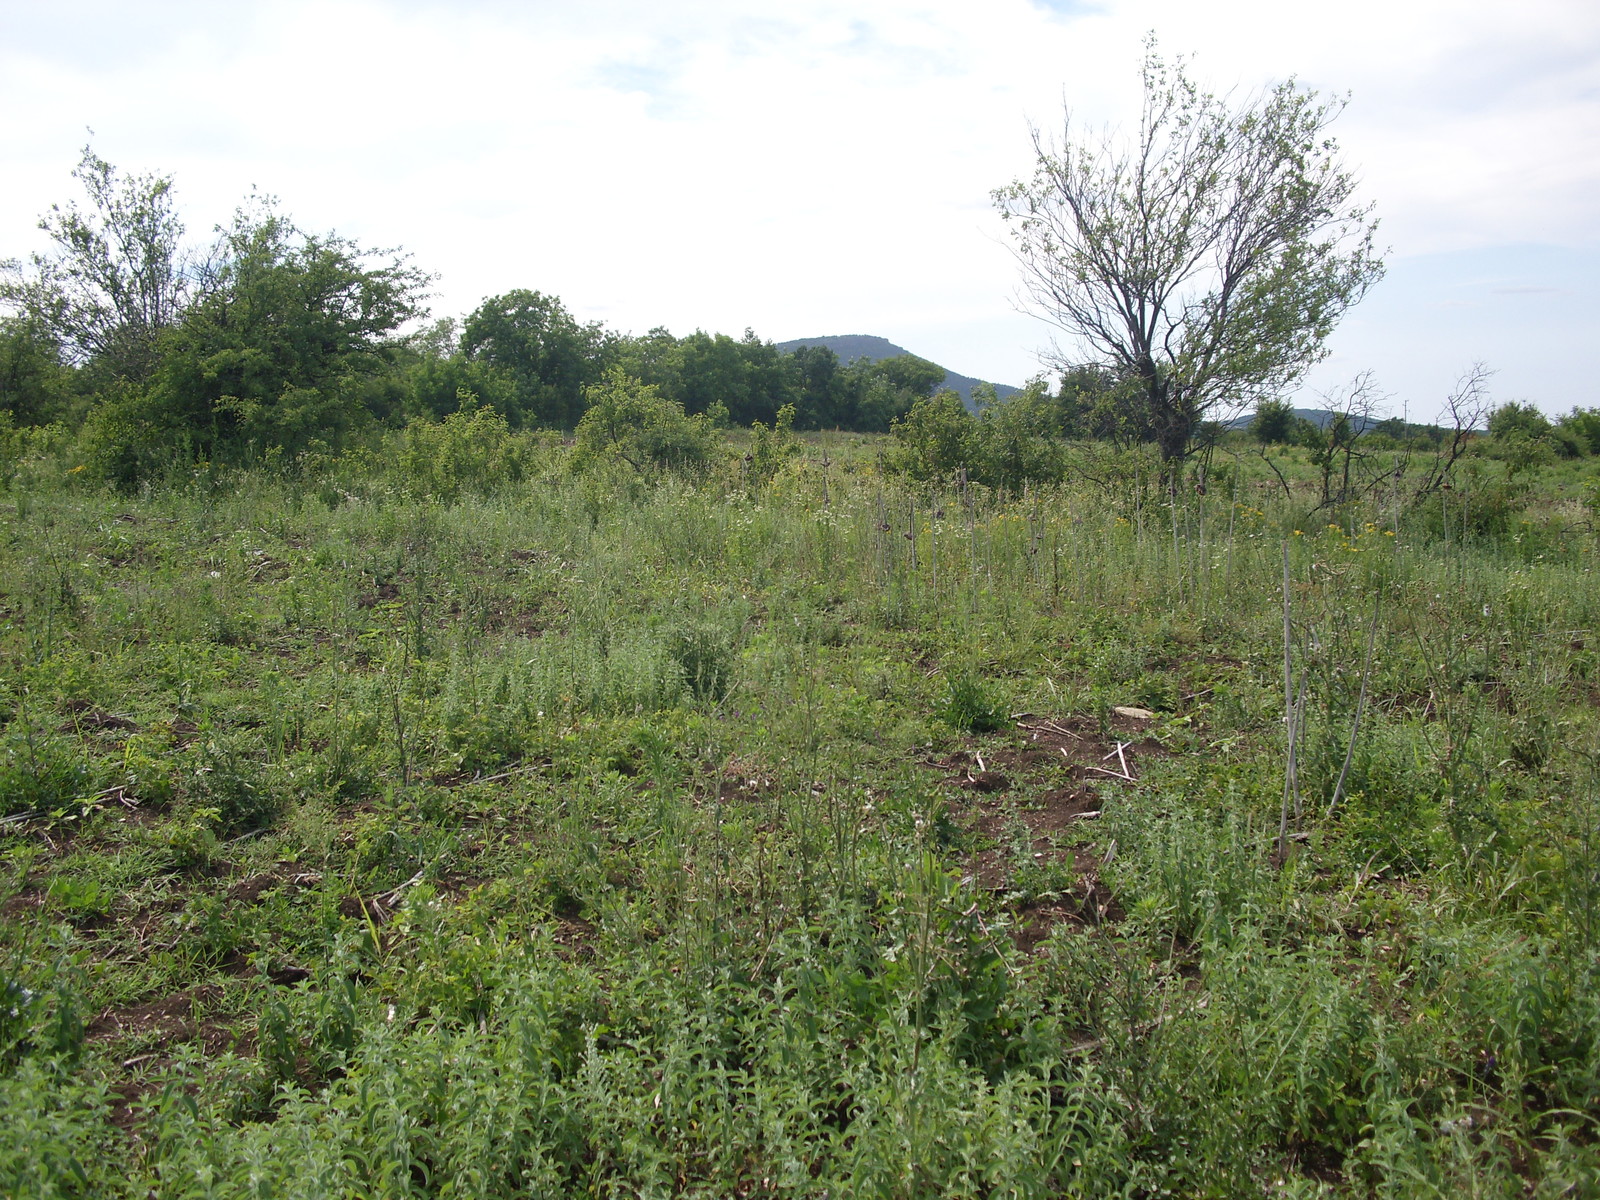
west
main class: Grassland
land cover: Spontaneously vegetated surfaces
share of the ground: 25 - 50 %
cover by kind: unconsolidated bare surface 55 %, herbaceous plants 45 %
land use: Fallow land
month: June
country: BG
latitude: 43.4401
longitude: 23.1226
